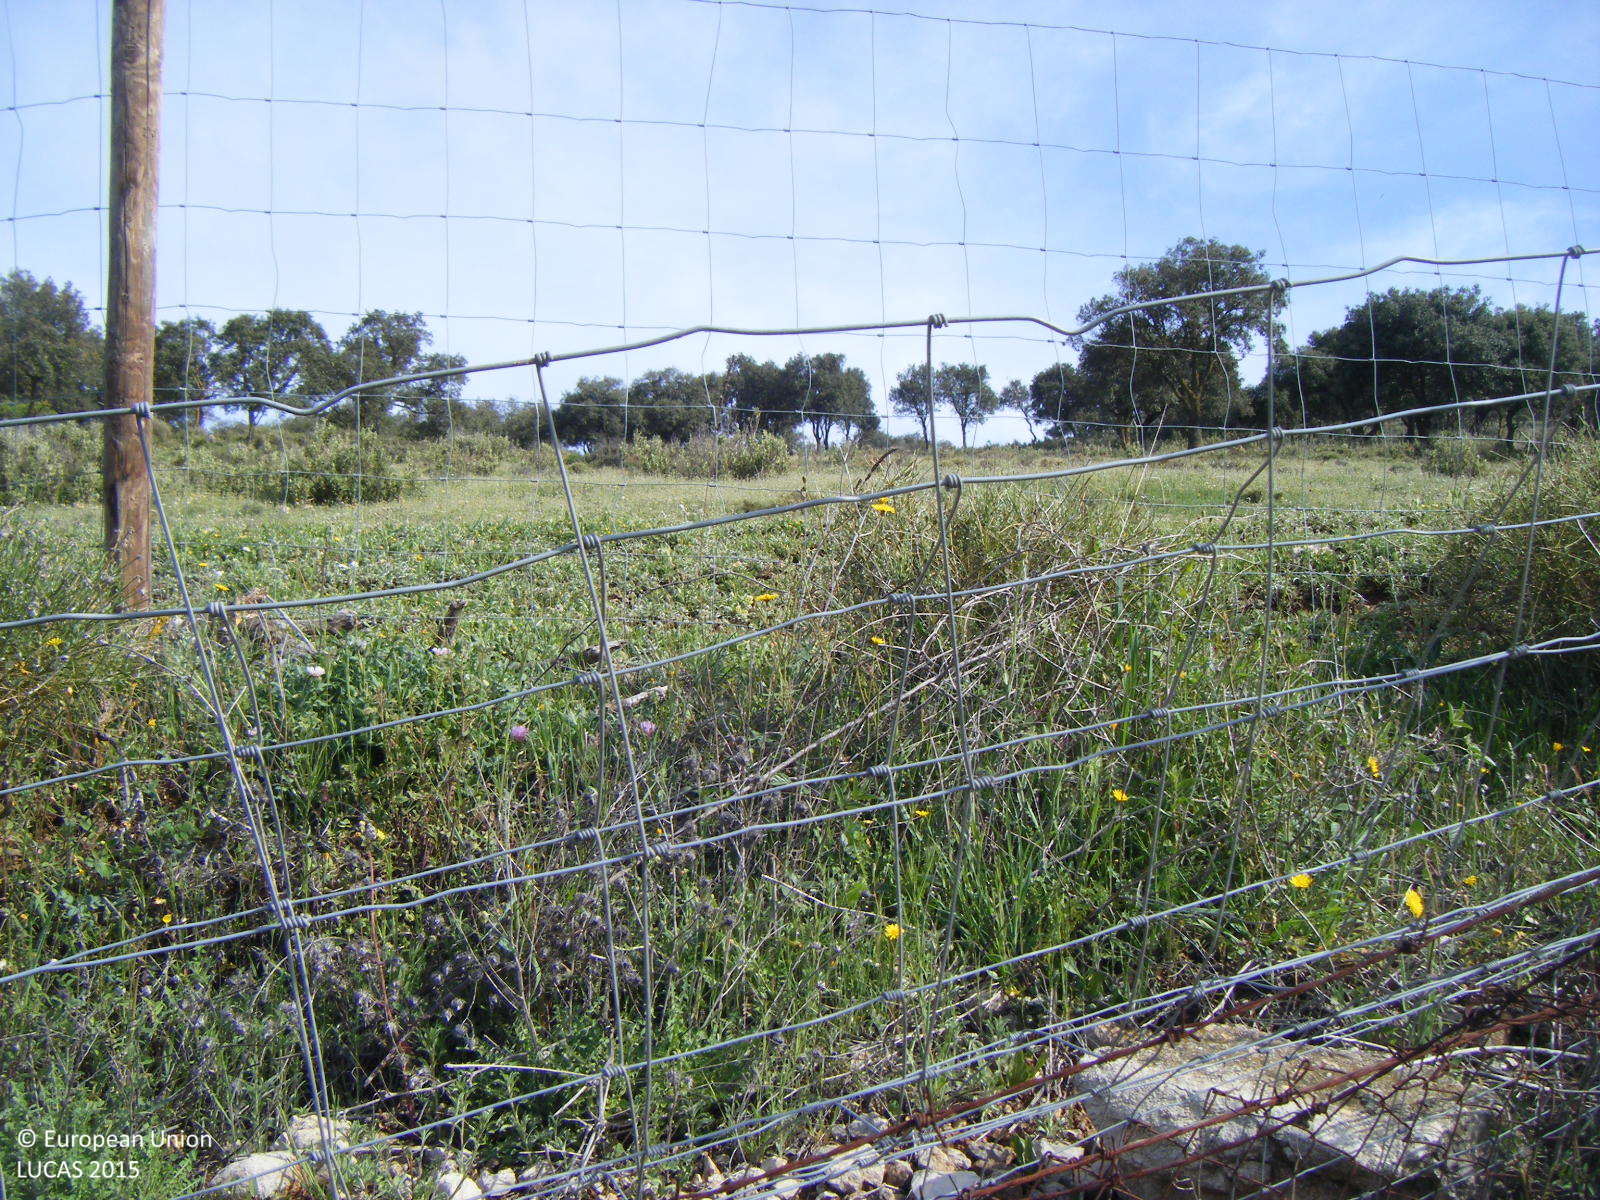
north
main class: Shrubland
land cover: Shrubland without tree cover
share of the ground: 25 - 50 %
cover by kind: herbaceous plants 60 %, shrubs 40 %
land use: Agriculture (excluding fallow land and kitchen gardens)
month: April
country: ES
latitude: 36.9543
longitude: -4.0617
